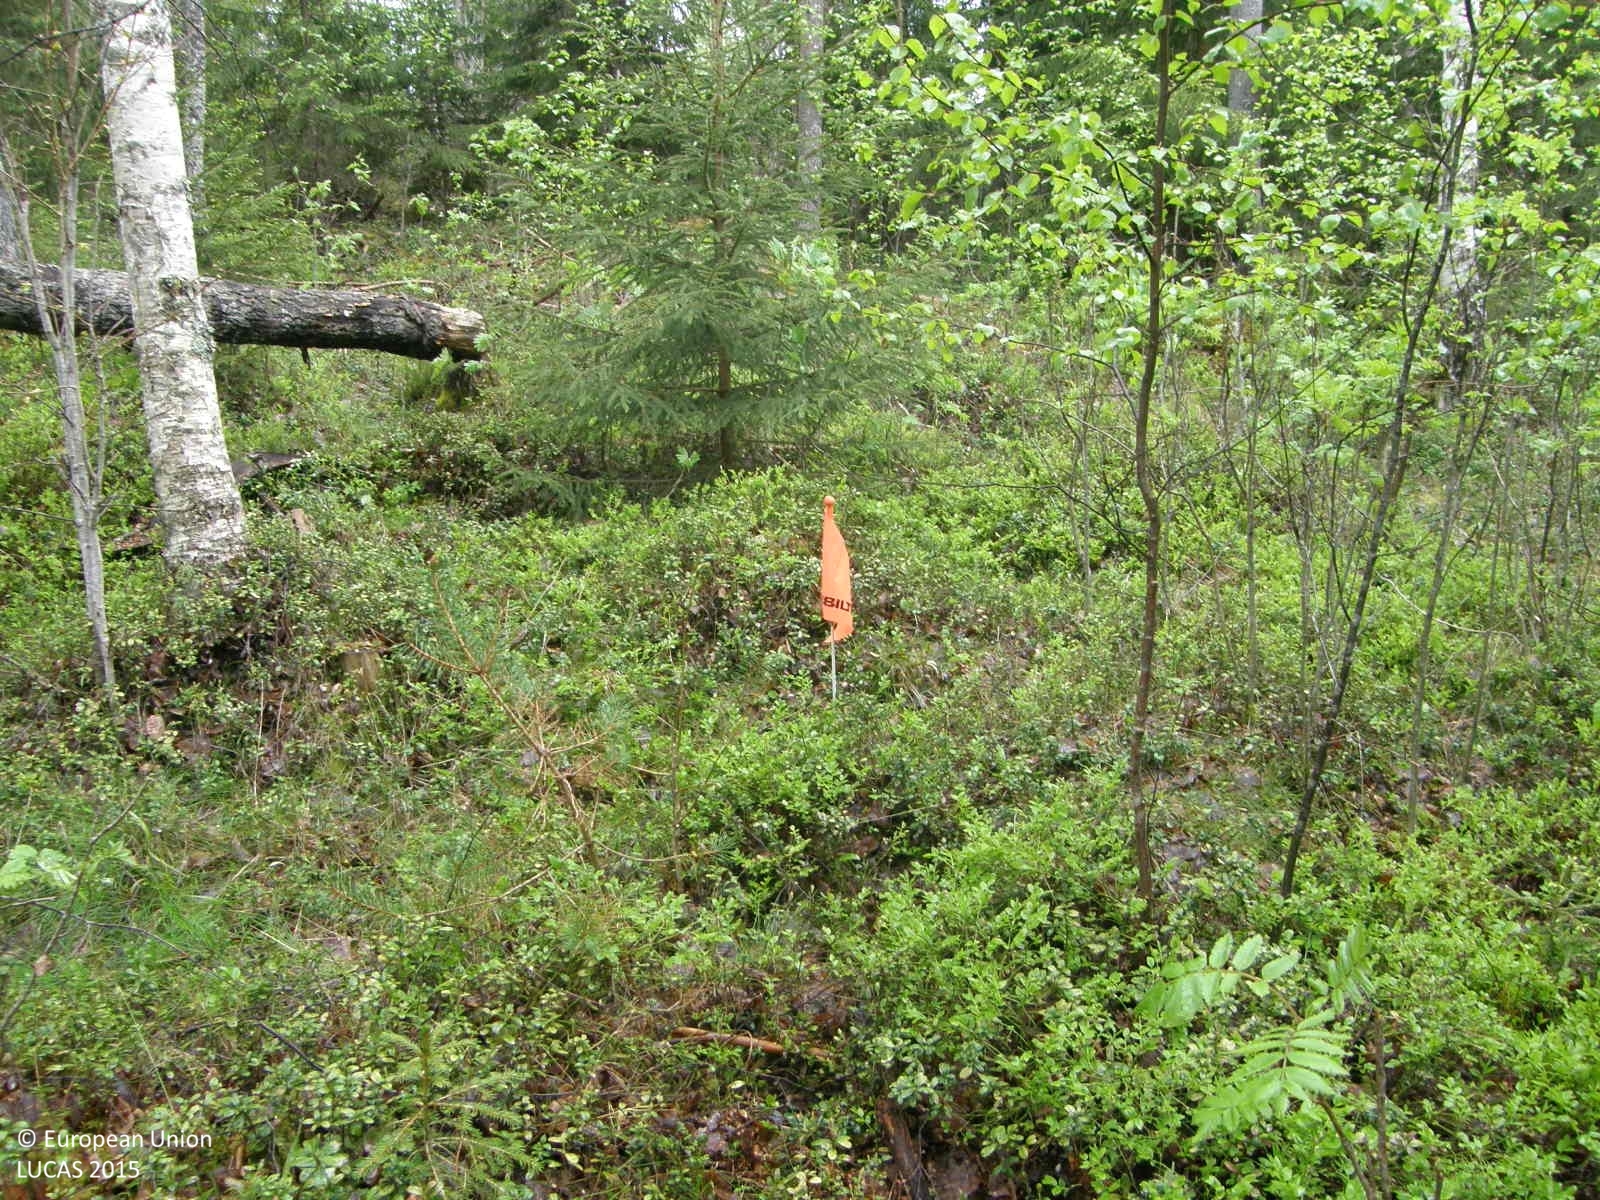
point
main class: Woodland
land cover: Other mixed woodland
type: boreal forest
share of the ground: > 75 %
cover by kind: coniferous forest trees 45 %, broadleaved forest trees 35 %, shrubs 20 %
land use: Forestry
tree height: > 5 m
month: June
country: FI
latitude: 61.9598
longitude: 21.6234
